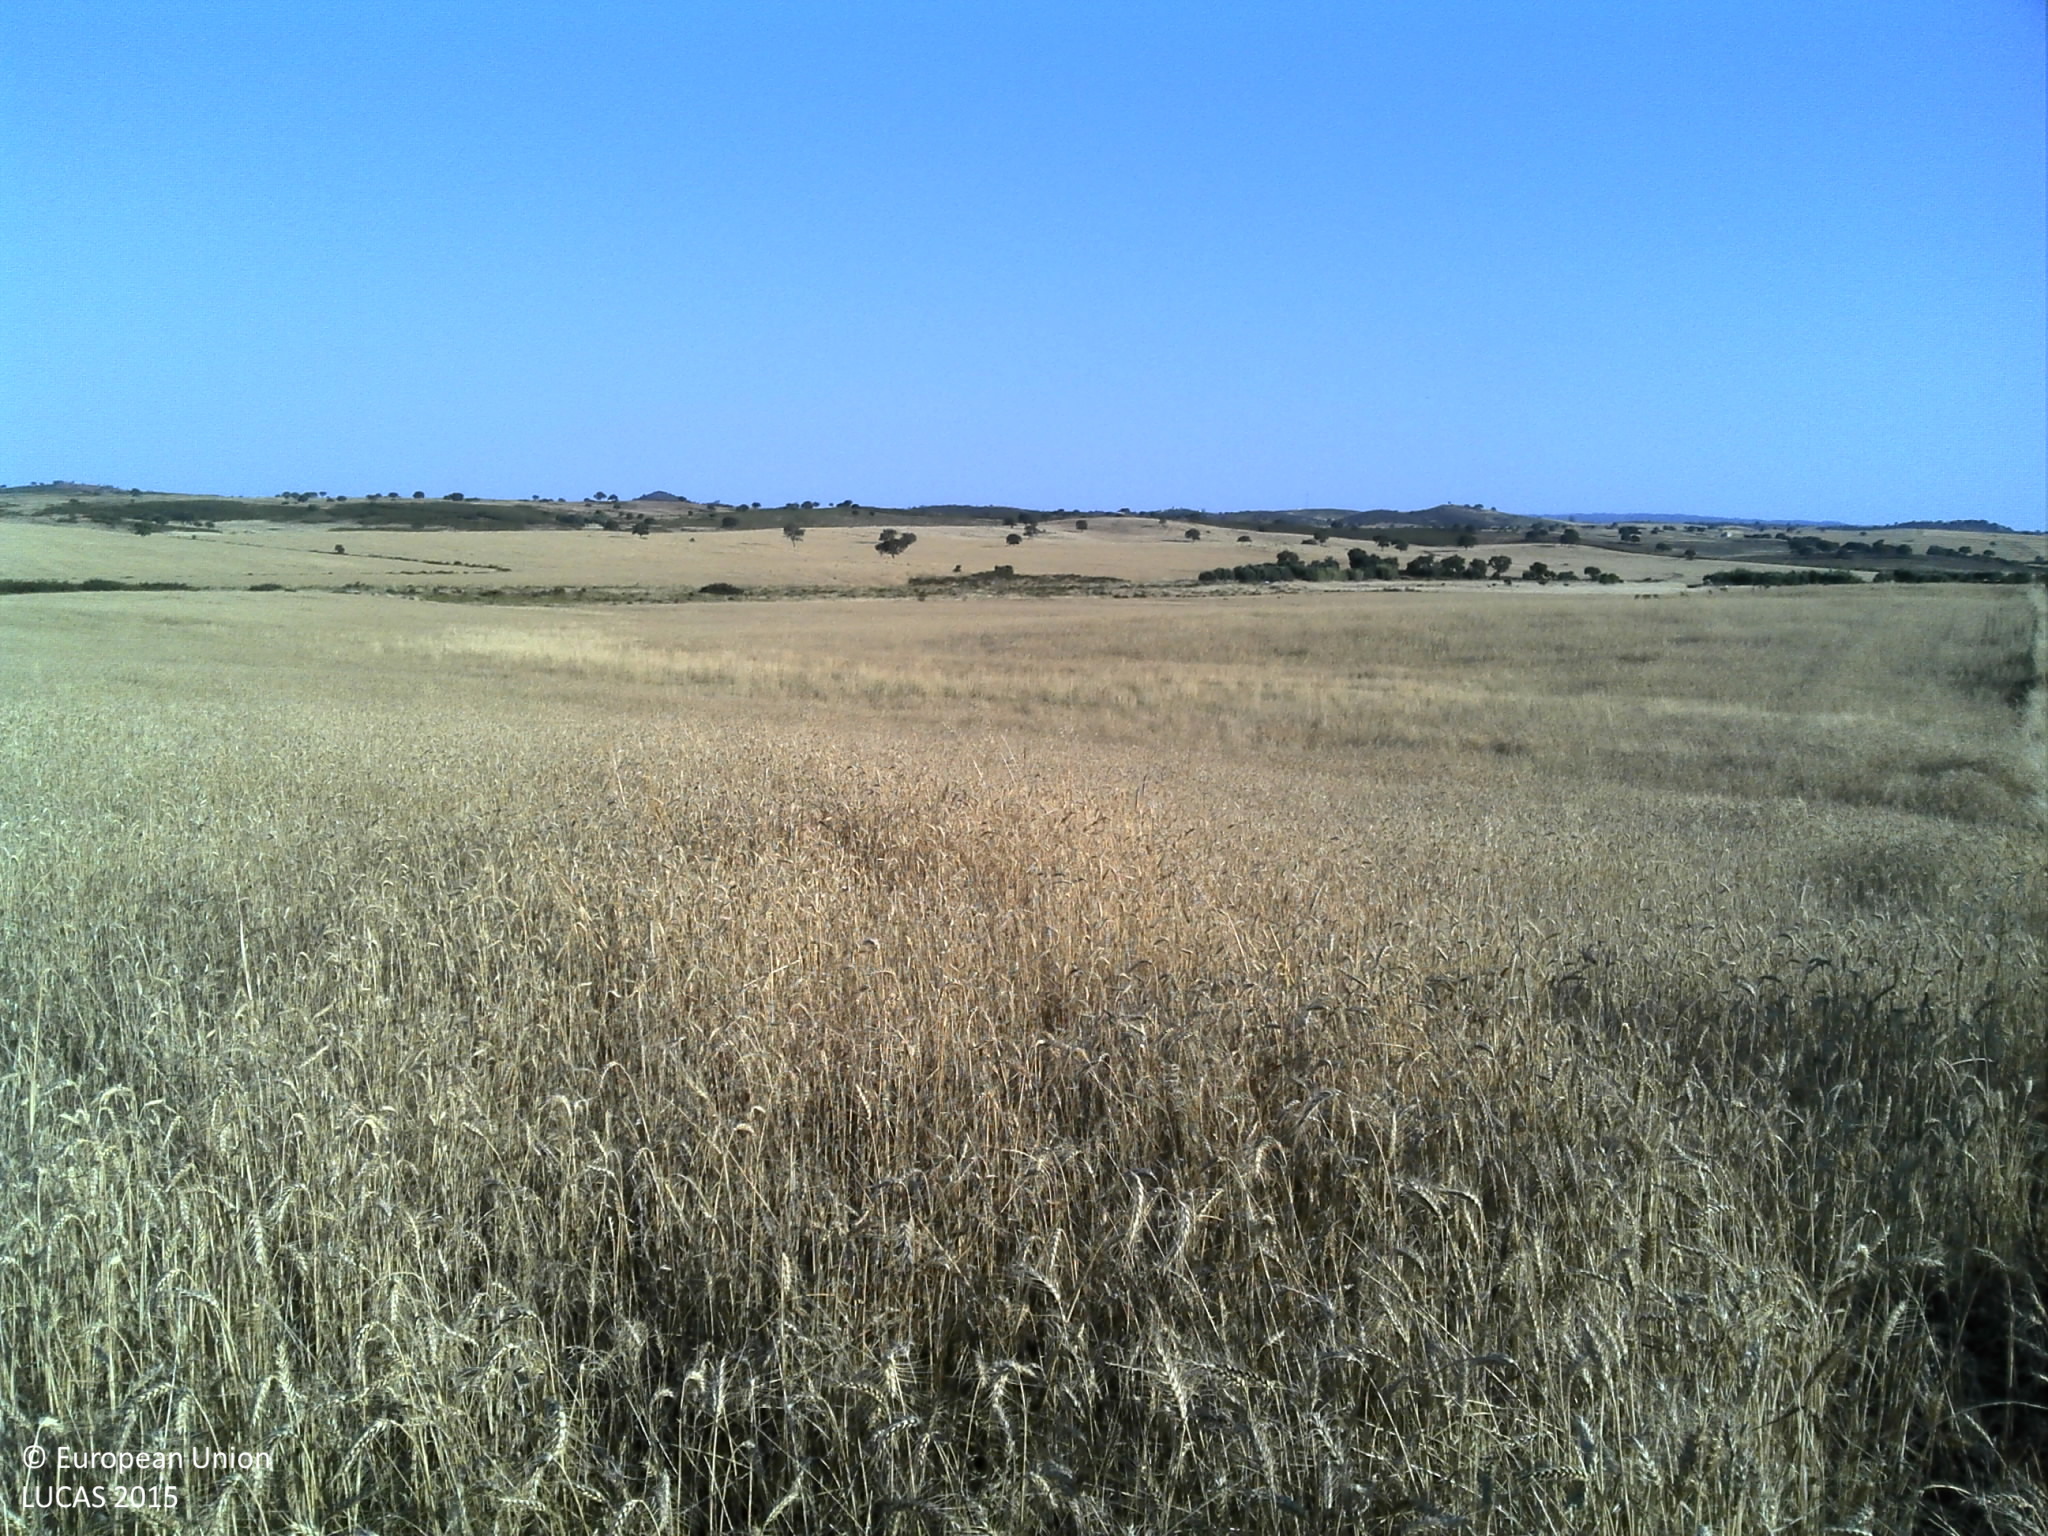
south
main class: Cropland
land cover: Common wheat
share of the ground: > 75 %
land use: Agriculture (excluding fallow land and kitchen gardens)
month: June
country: PT
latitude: 37.4745
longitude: -7.9180
